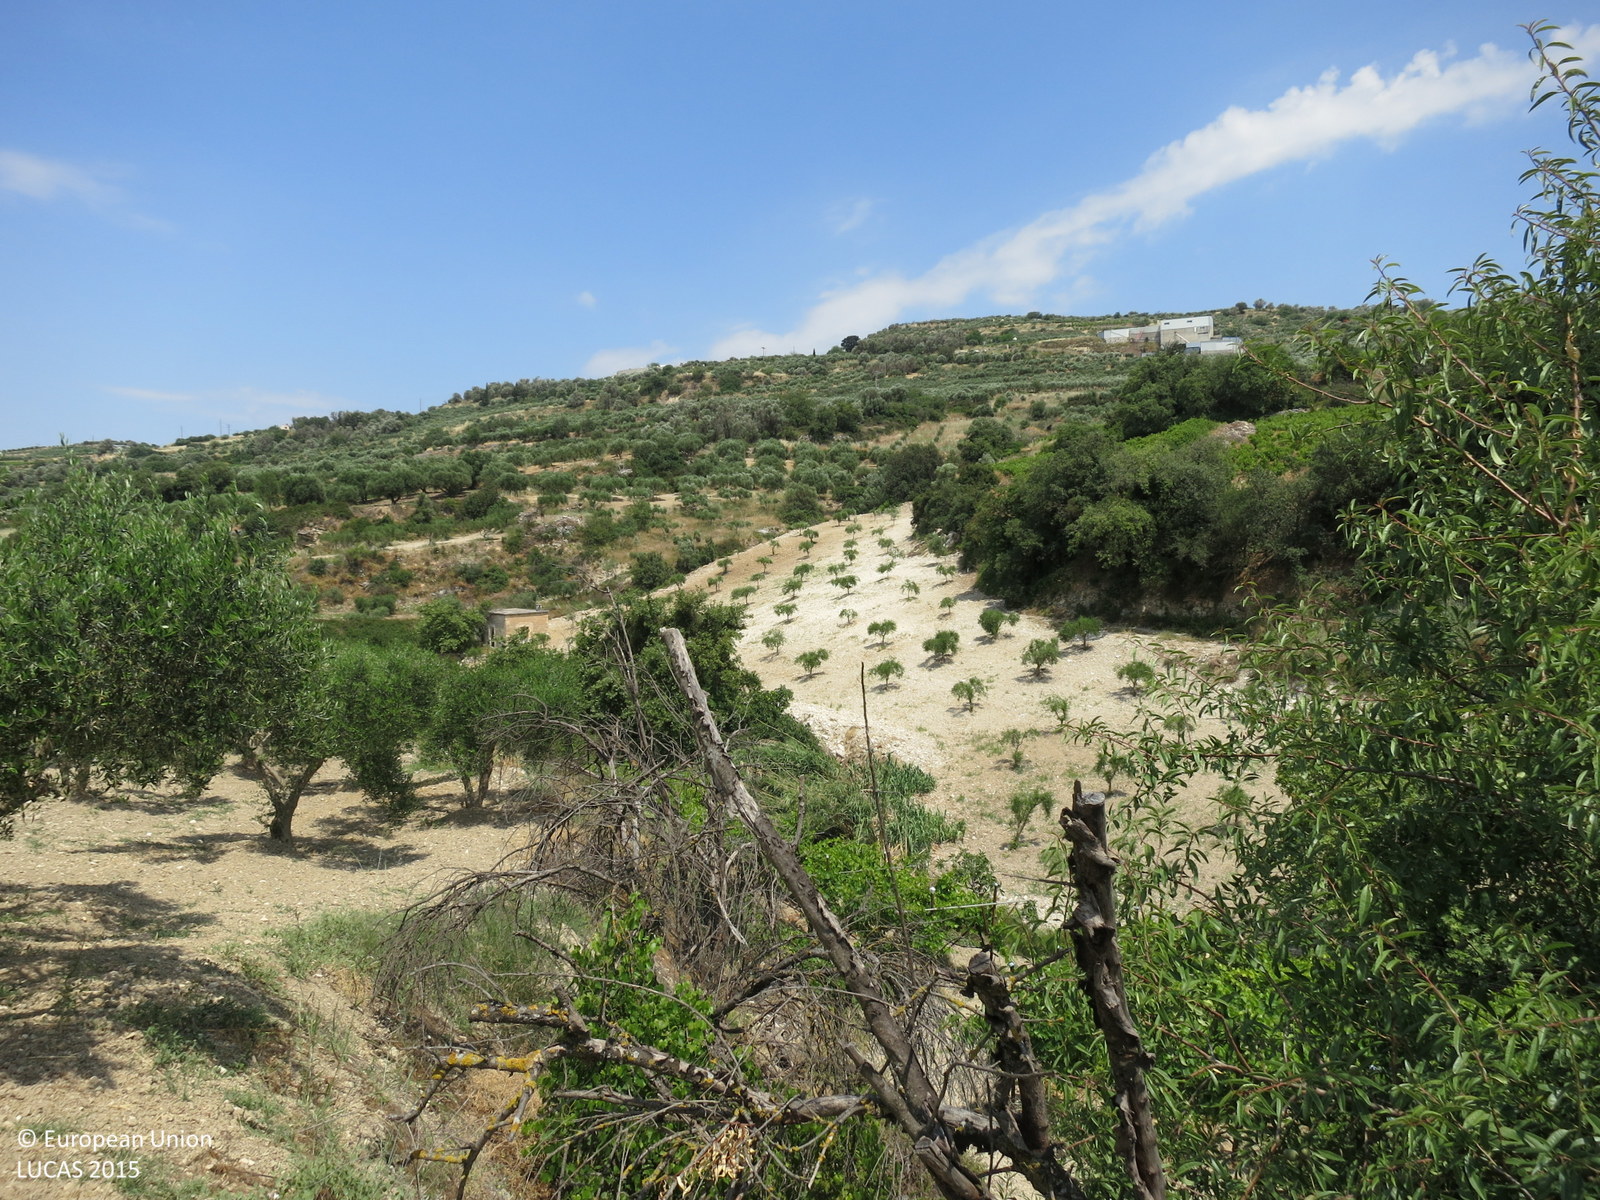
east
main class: Cropland
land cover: Olive groves
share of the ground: 25 - 50 %
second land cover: Other bare soil
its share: > 75 %
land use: Agriculture (excluding fallow land and kitchen gardens)
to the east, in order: Olive groves; Other bare soil; Abandoned hedges; Vineyards; Abandoned hedges; Rivers and streams; Abandoned hedges; Olive groves; Shrubland without tree cover; Ditches and canals; Shrubland without tree cover; Vineyards; Olive groves; Dry stone walls; Olive groves; Dry stone walls; Olive groves
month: June
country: GR
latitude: 35.2225
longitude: 25.0083
